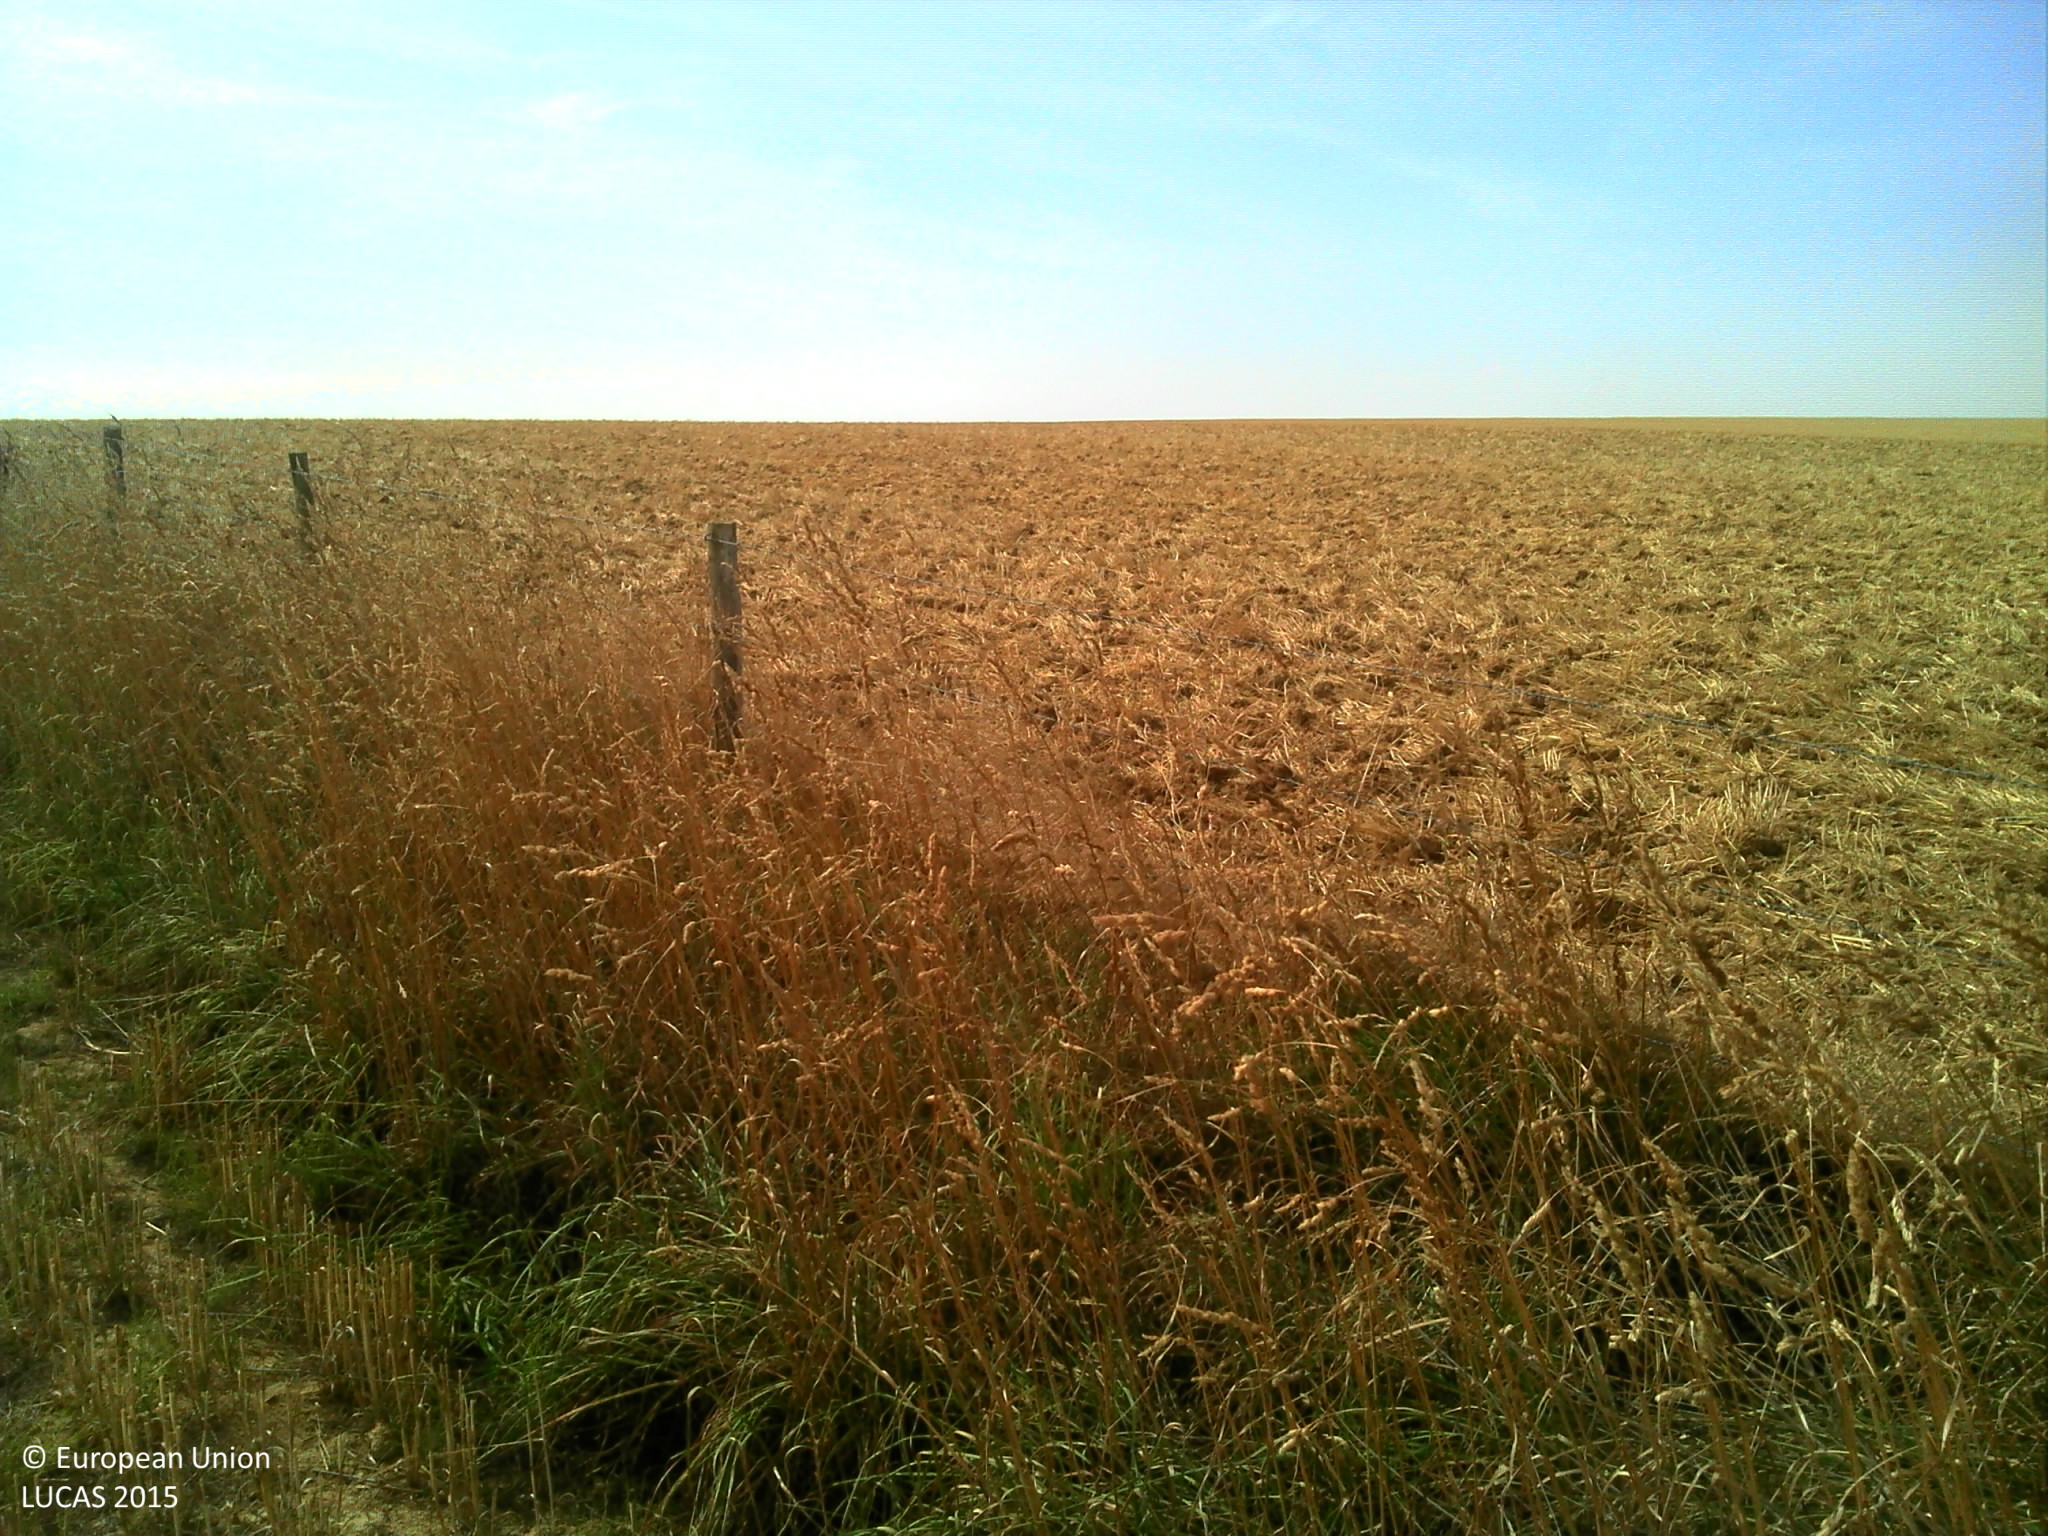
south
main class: Cropland
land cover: Common wheat
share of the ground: > 75 %
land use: Agriculture (excluding fallow land and kitchen gardens)
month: August
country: FR
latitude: 48.9055
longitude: 3.3212
